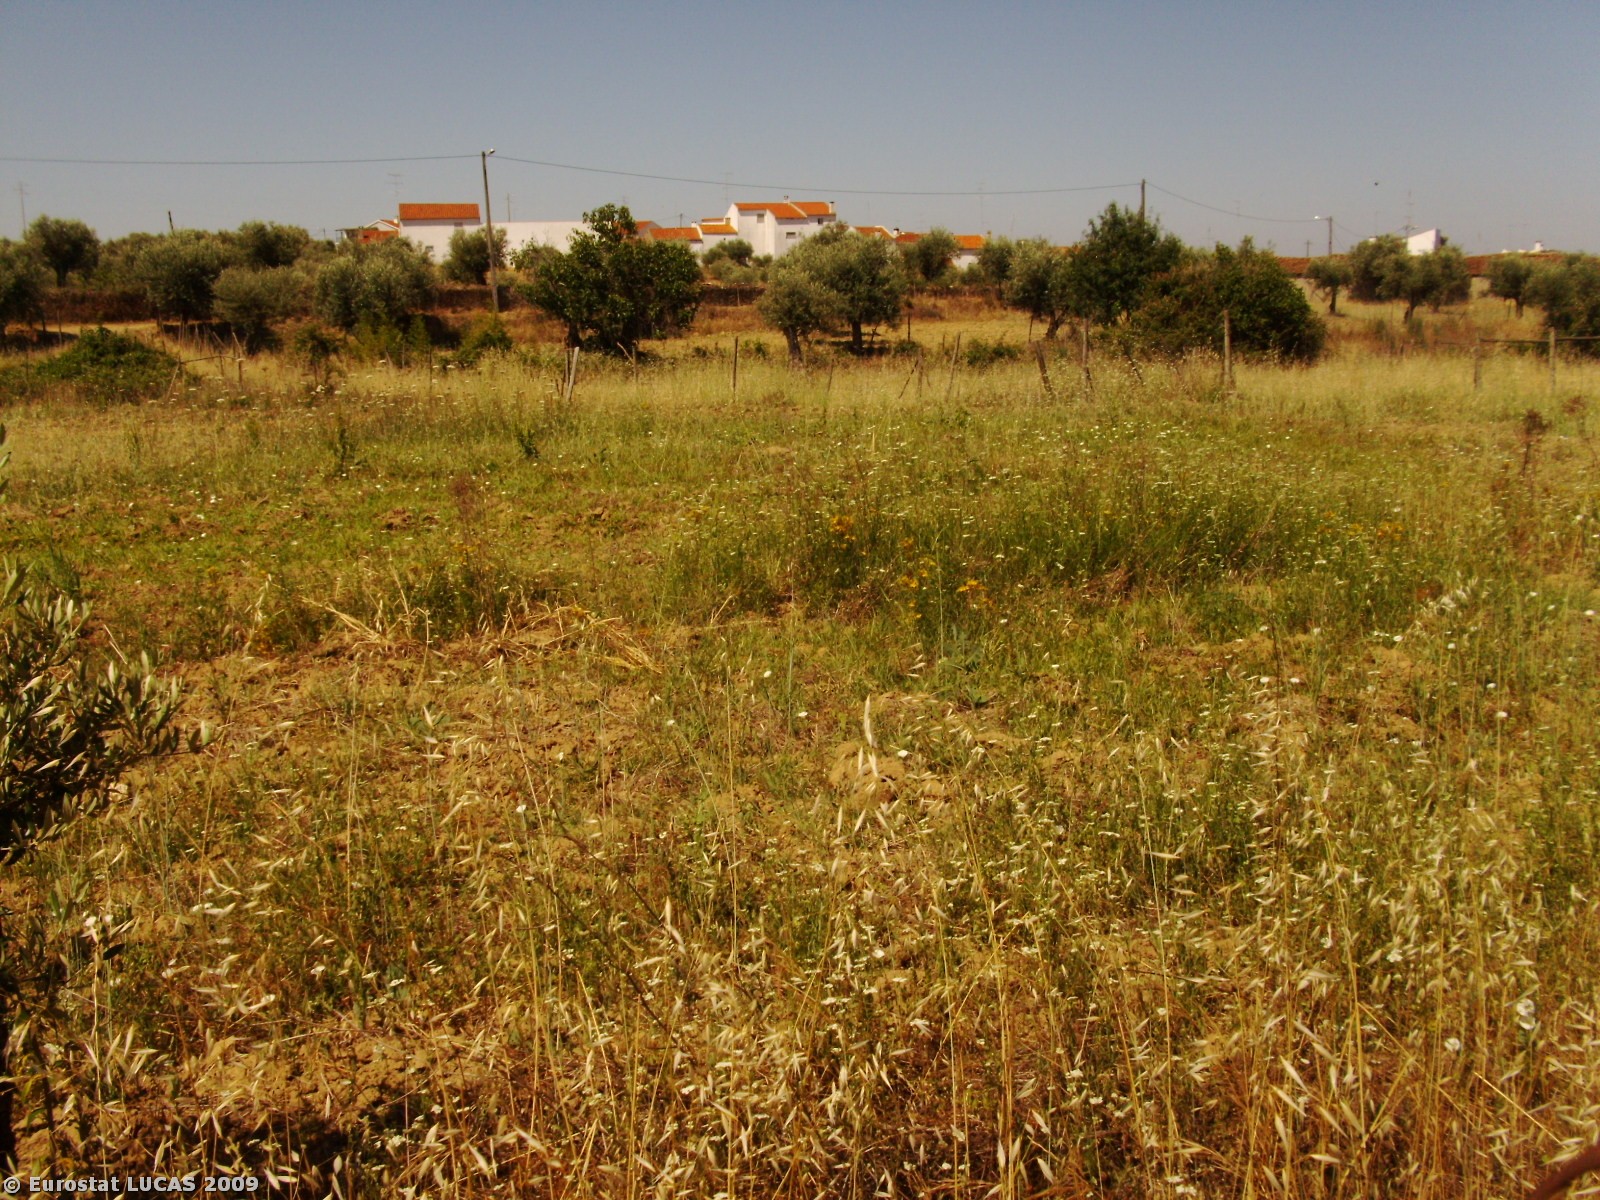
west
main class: Grassland
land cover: Spontaneously vegetated surfaces
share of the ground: > 75 %
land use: Fallow land
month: June
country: PT
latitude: 39.8319
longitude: -7.2583
